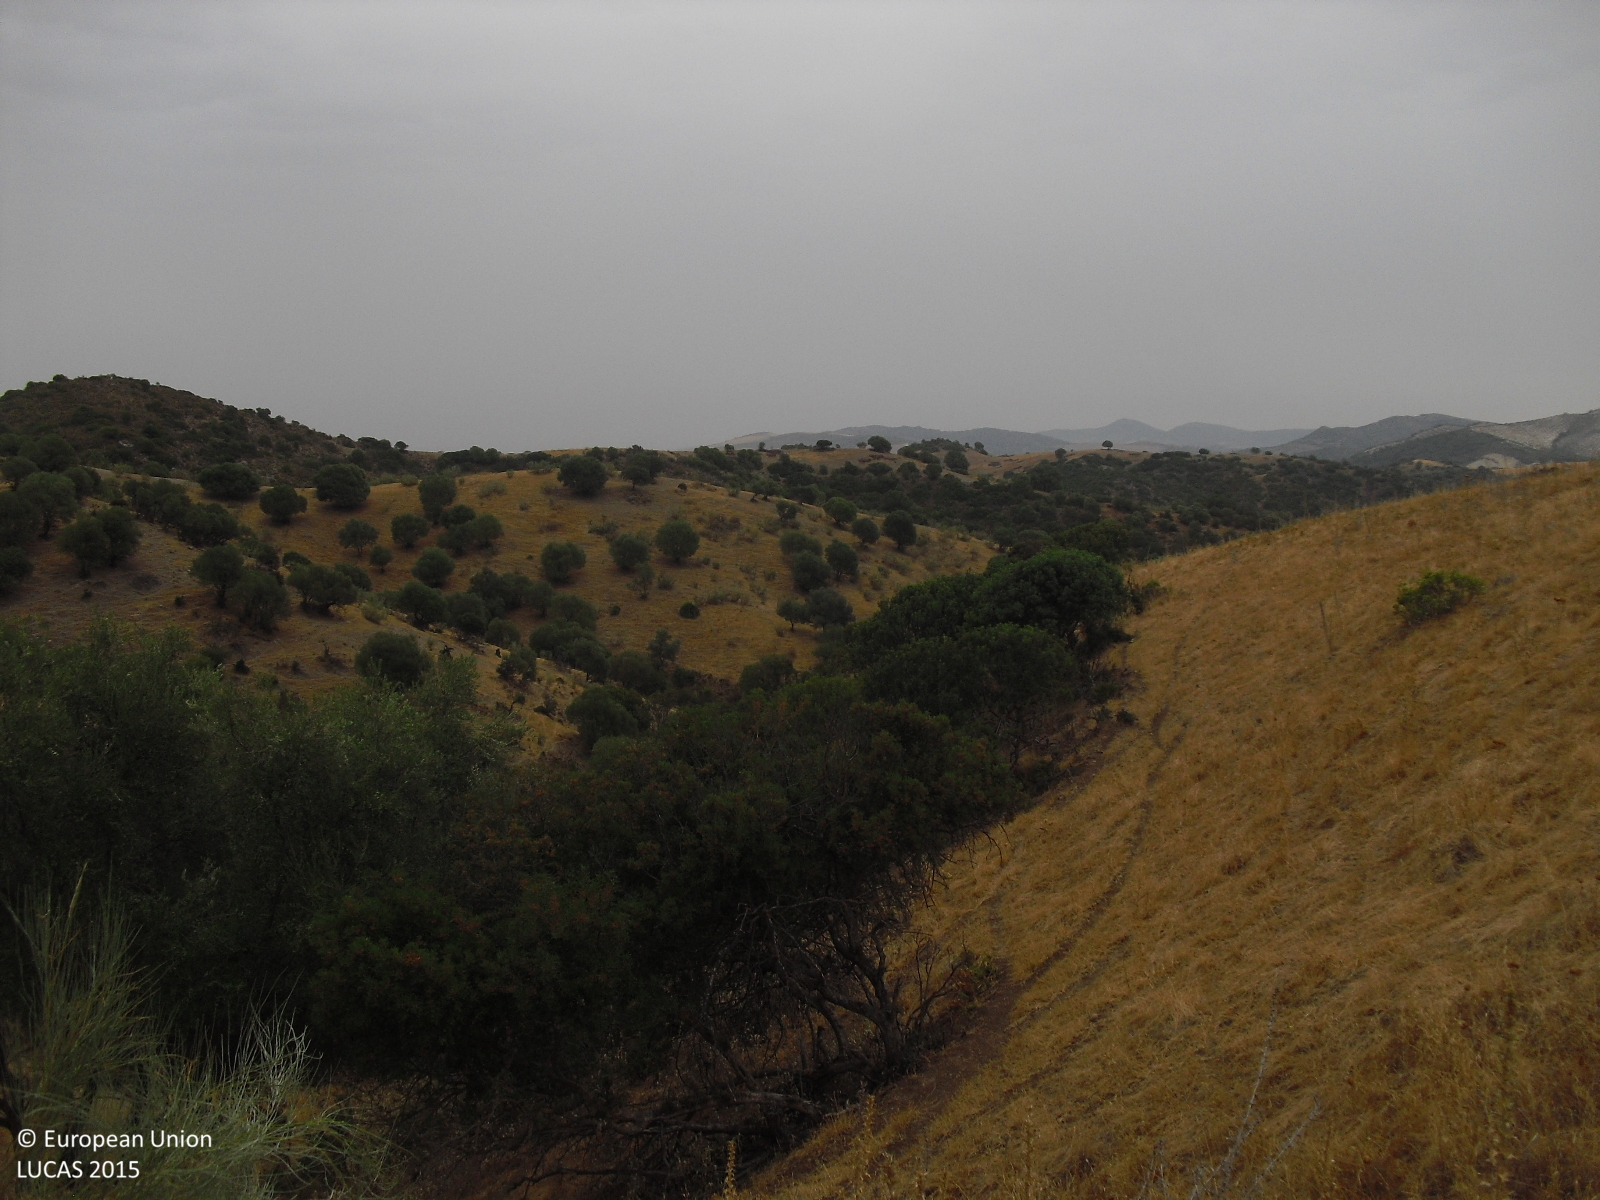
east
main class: Grassland
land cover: Grassland without tree/shrub cover
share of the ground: > 75 %
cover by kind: herbaceous plants 95 %, unconsolidated bare surface 5 %
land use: Agriculture (excluding fallow land and kitchen gardens)
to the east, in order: Grassland without tree/shrub cover; Shrubland with sparse tree cover; Shrubland without tree cover; Shrubland with sparse tree cover; Rivers and streams; Broadleaved woodland
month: August
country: ES
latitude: 37.1410
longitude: -5.3308
